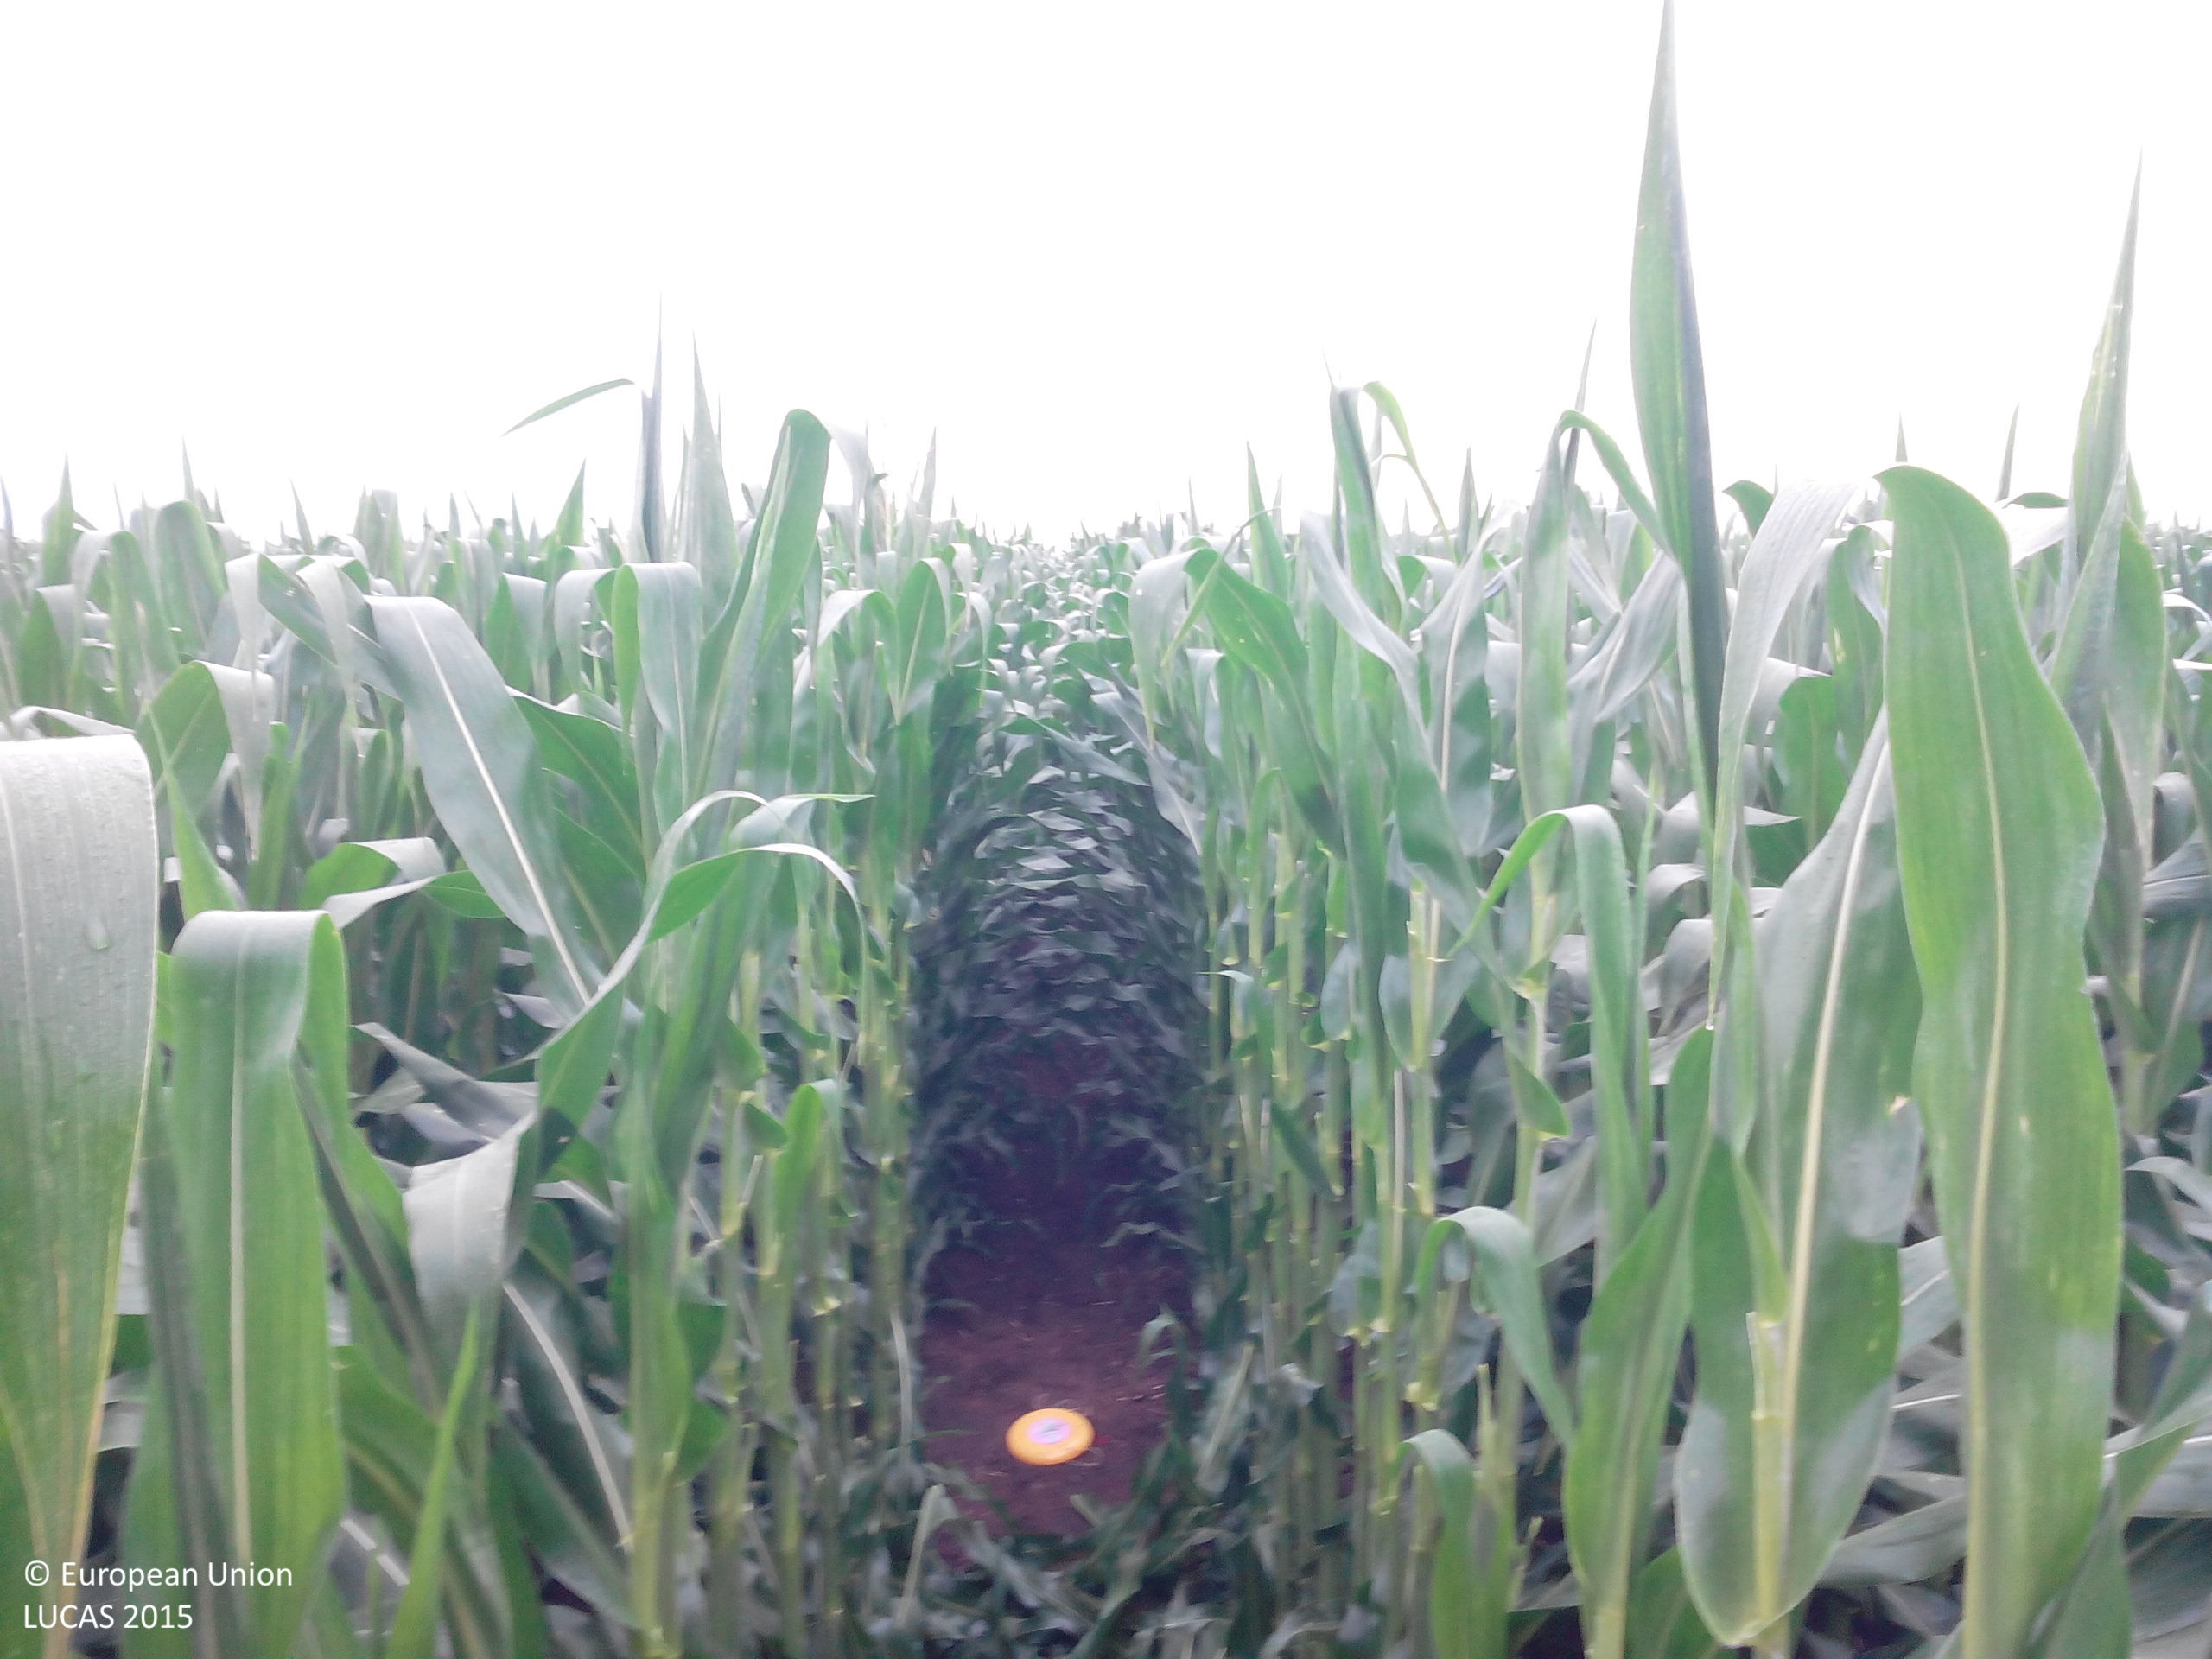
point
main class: Cropland
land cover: Maize
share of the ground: > 75 %
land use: Agriculture (excluding fallow land and kitchen gardens)
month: July
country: BG
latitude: 43.4689
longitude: 24.1341
